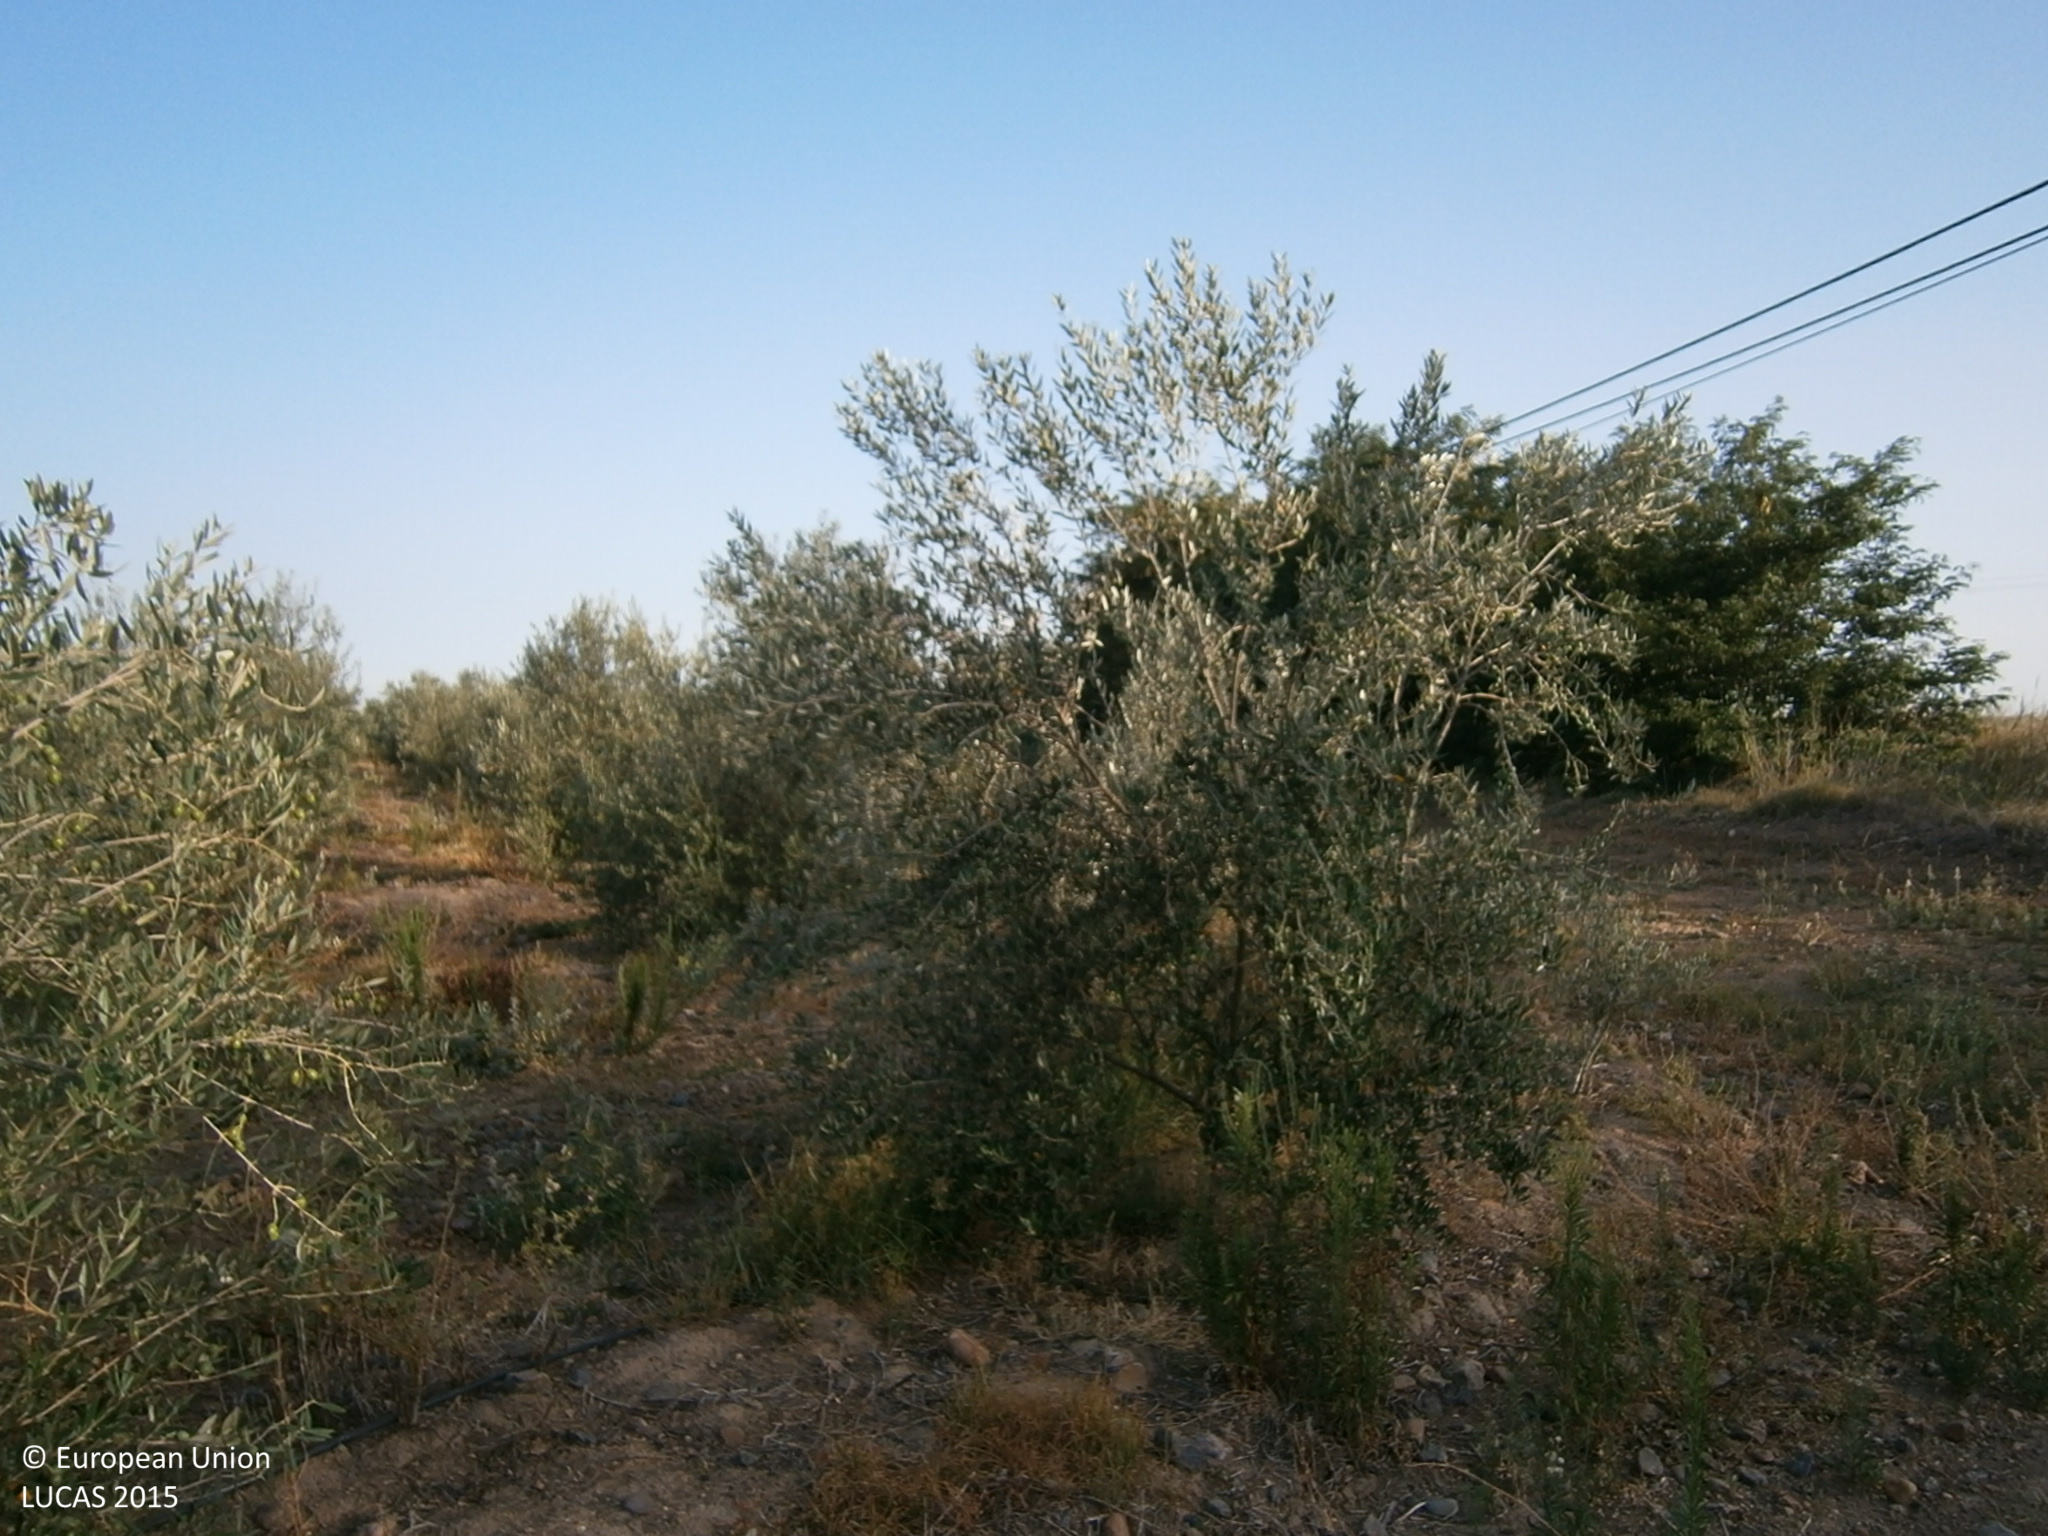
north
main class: Cropland
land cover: Olive groves
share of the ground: 25 - 50 %
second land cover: Spontaneously vegetated surfaces
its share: 25 - 50 %
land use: Agriculture (excluding fallow land and kitchen gardens)
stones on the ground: 10 - 25 %
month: July
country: ES
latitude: 38.8820
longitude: -6.7926
